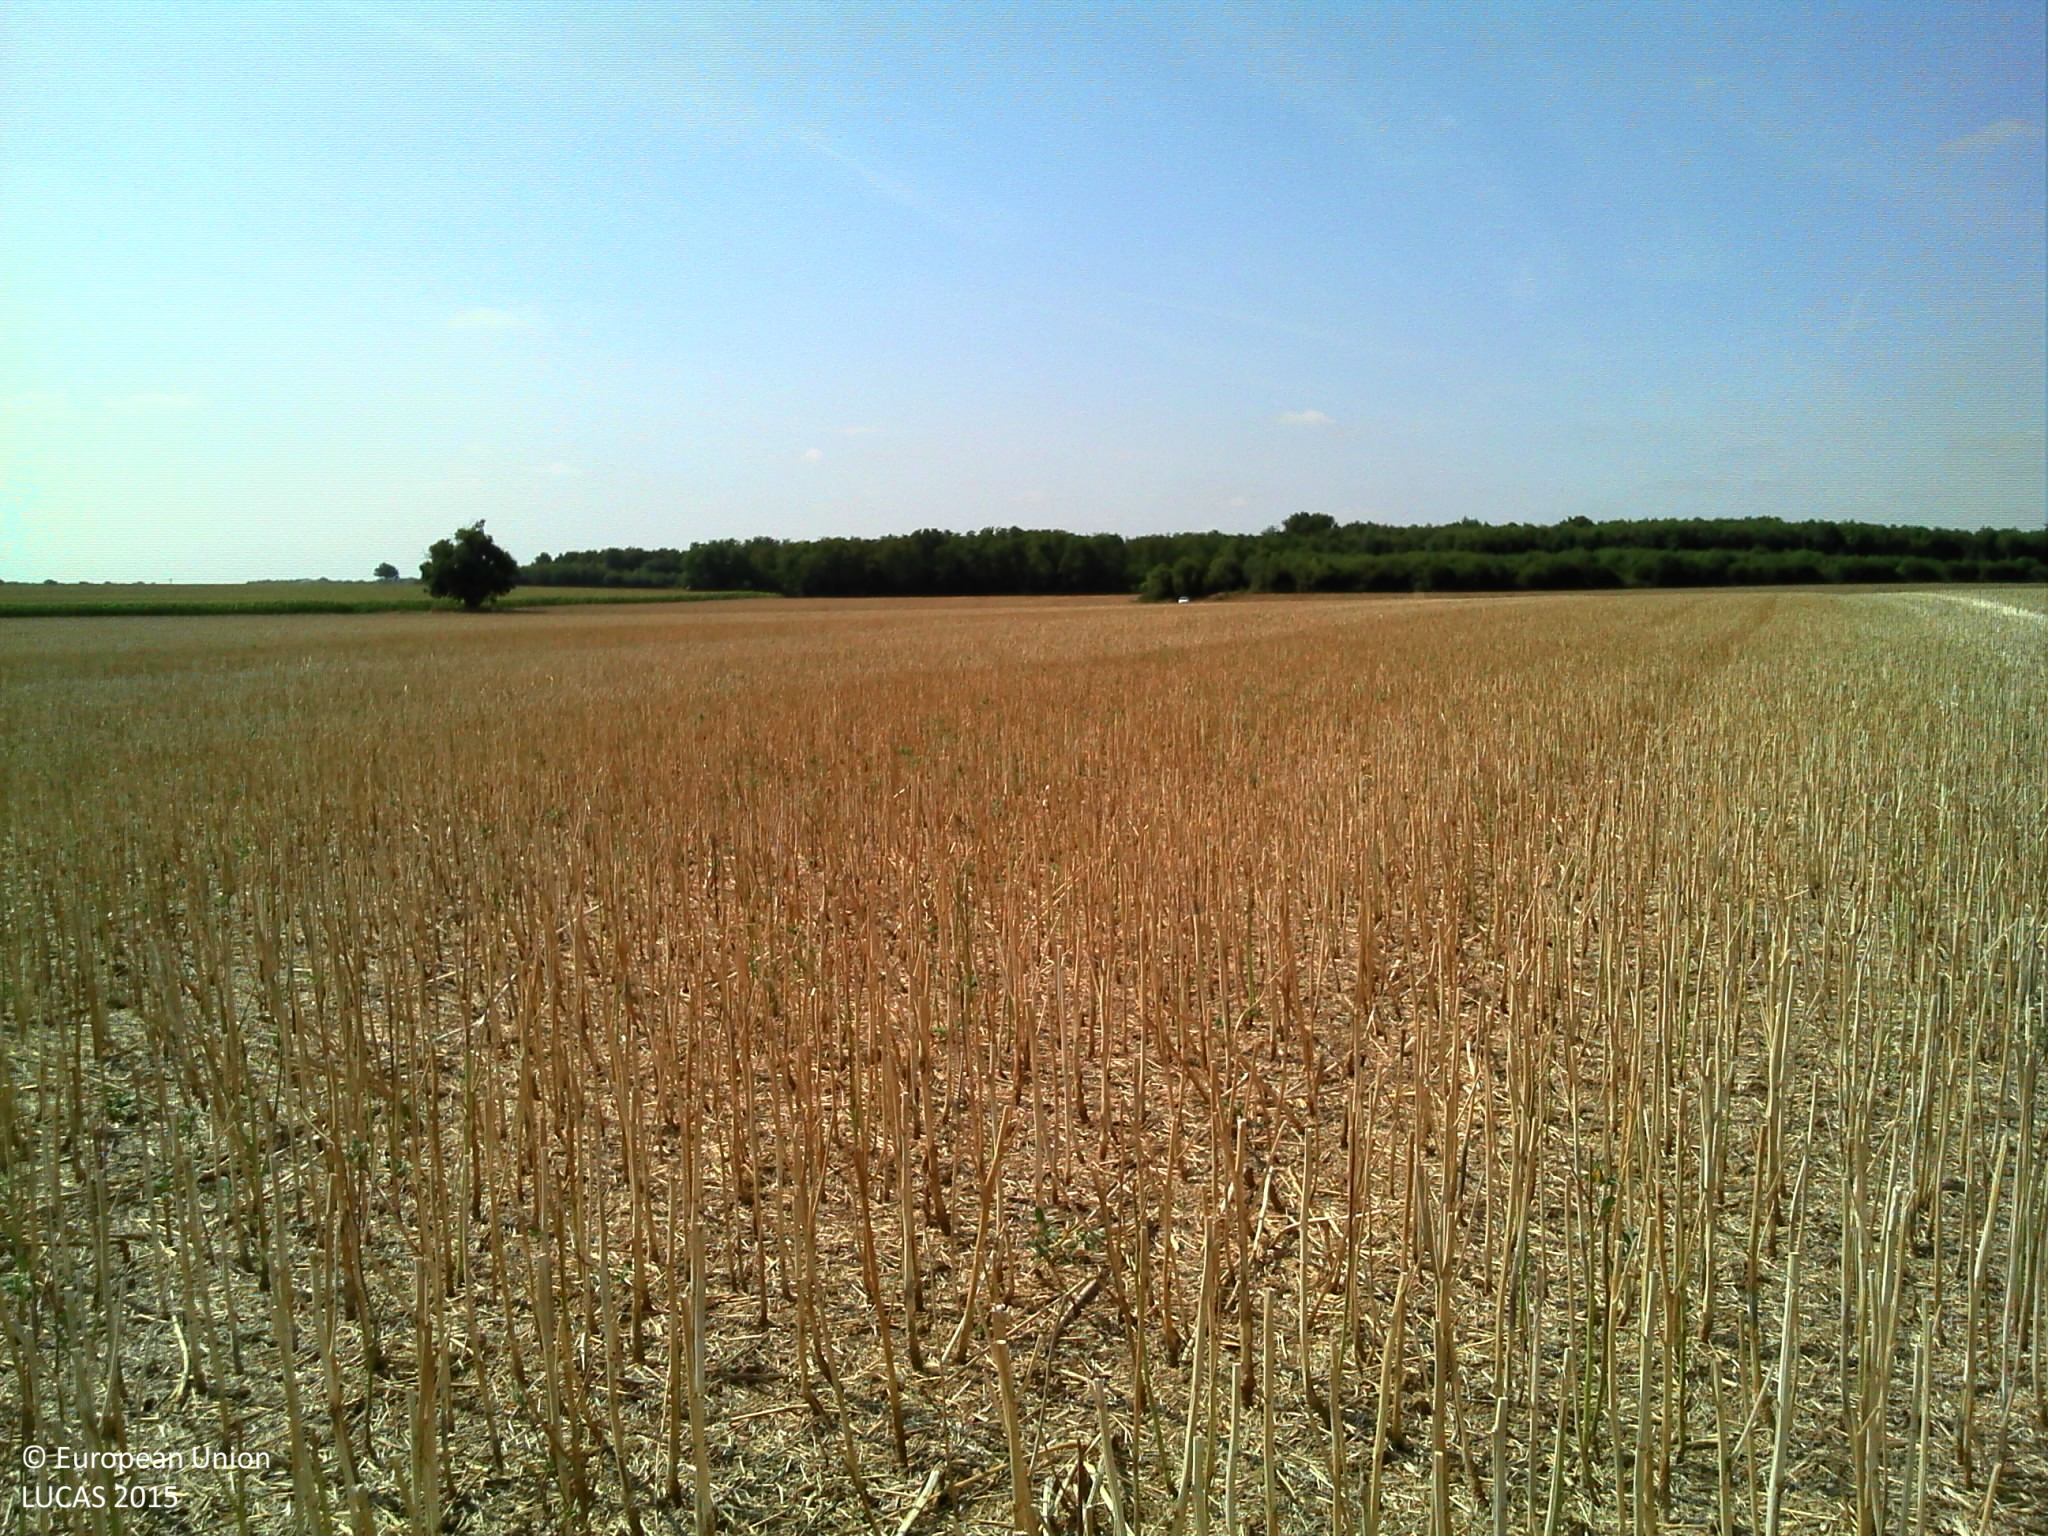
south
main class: Cropland
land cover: Rape and turnip rape
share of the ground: < 10 %
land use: Agriculture (excluding fallow land and kitchen gardens)
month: August
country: FR
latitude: 46.2556
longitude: 0.3178
